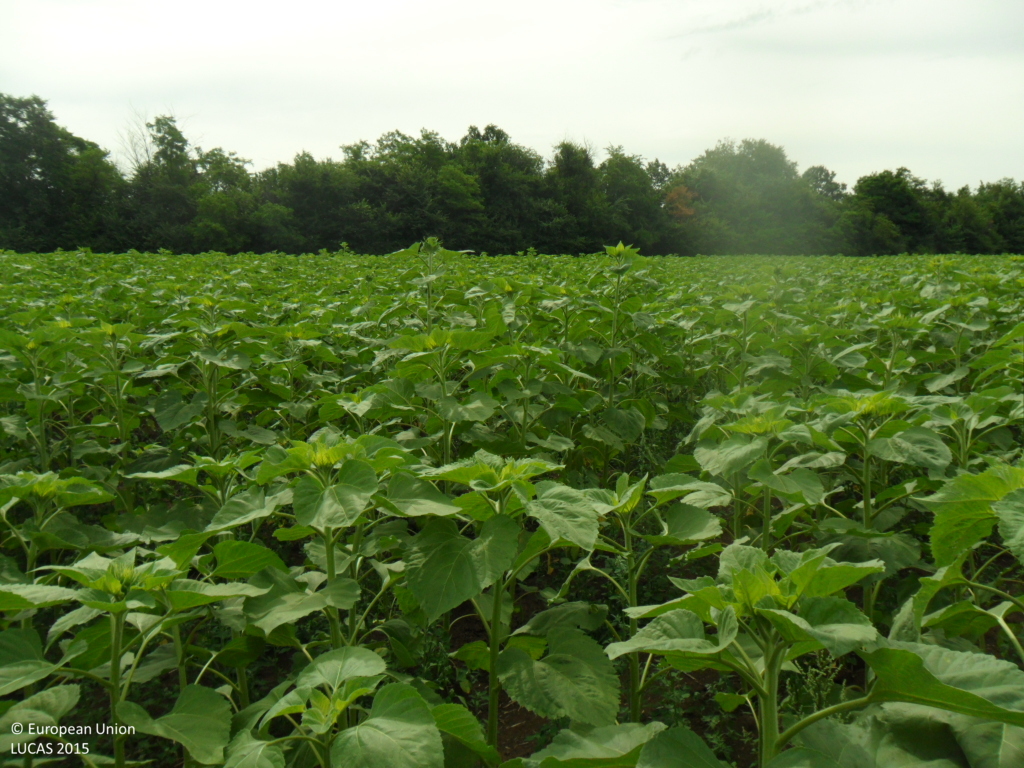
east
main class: Cropland
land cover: Sunflower
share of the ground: > 75 %
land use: Agriculture (excluding fallow land and kitchen gardens)
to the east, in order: Sunflower; Tracks; Grass margins; Broadleaved woodland; Grass margins; Nuts trees
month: June
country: BG
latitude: 43.7105
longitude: 26.9857
